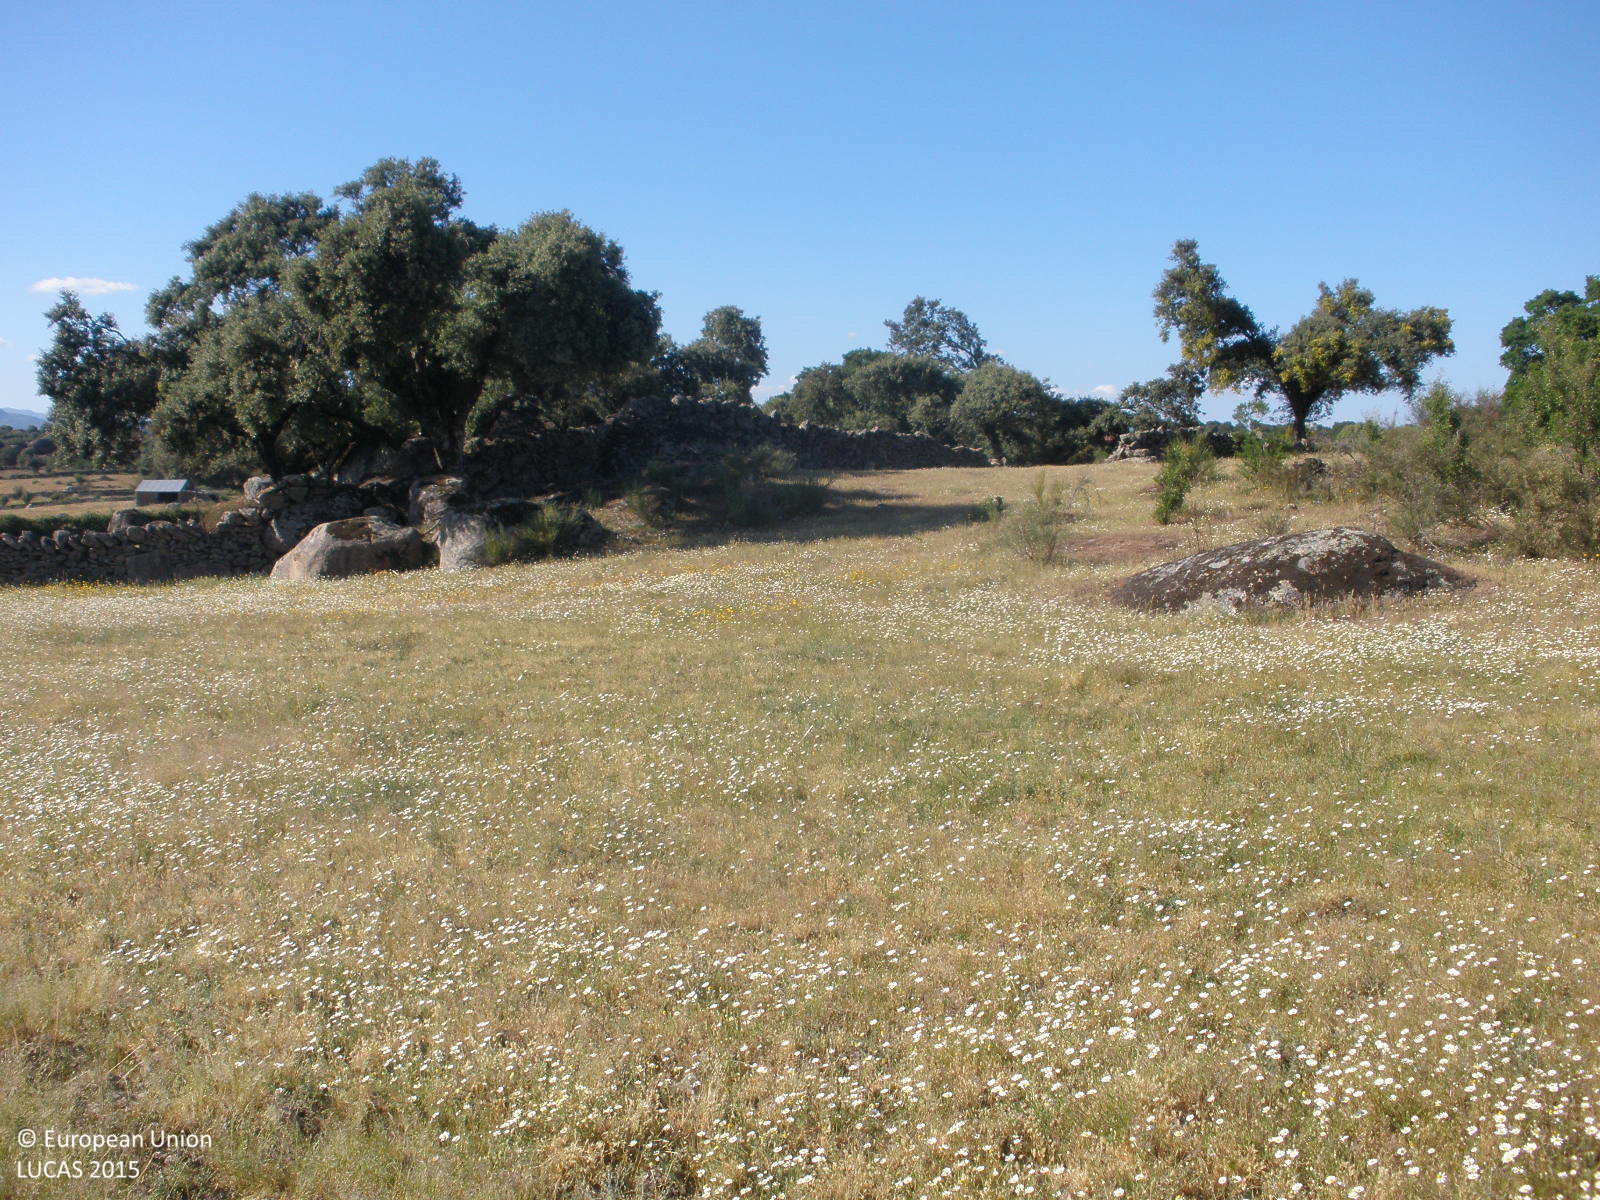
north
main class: Grassland
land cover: Grassland without tree/shrub cover
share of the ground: > 75 %
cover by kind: herbaceous plants 90 %, consolidated bare surface 10 %
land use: Agriculture (excluding fallow land and kitchen gardens)
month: May
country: ES
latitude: 40.1555
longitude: -6.2425
